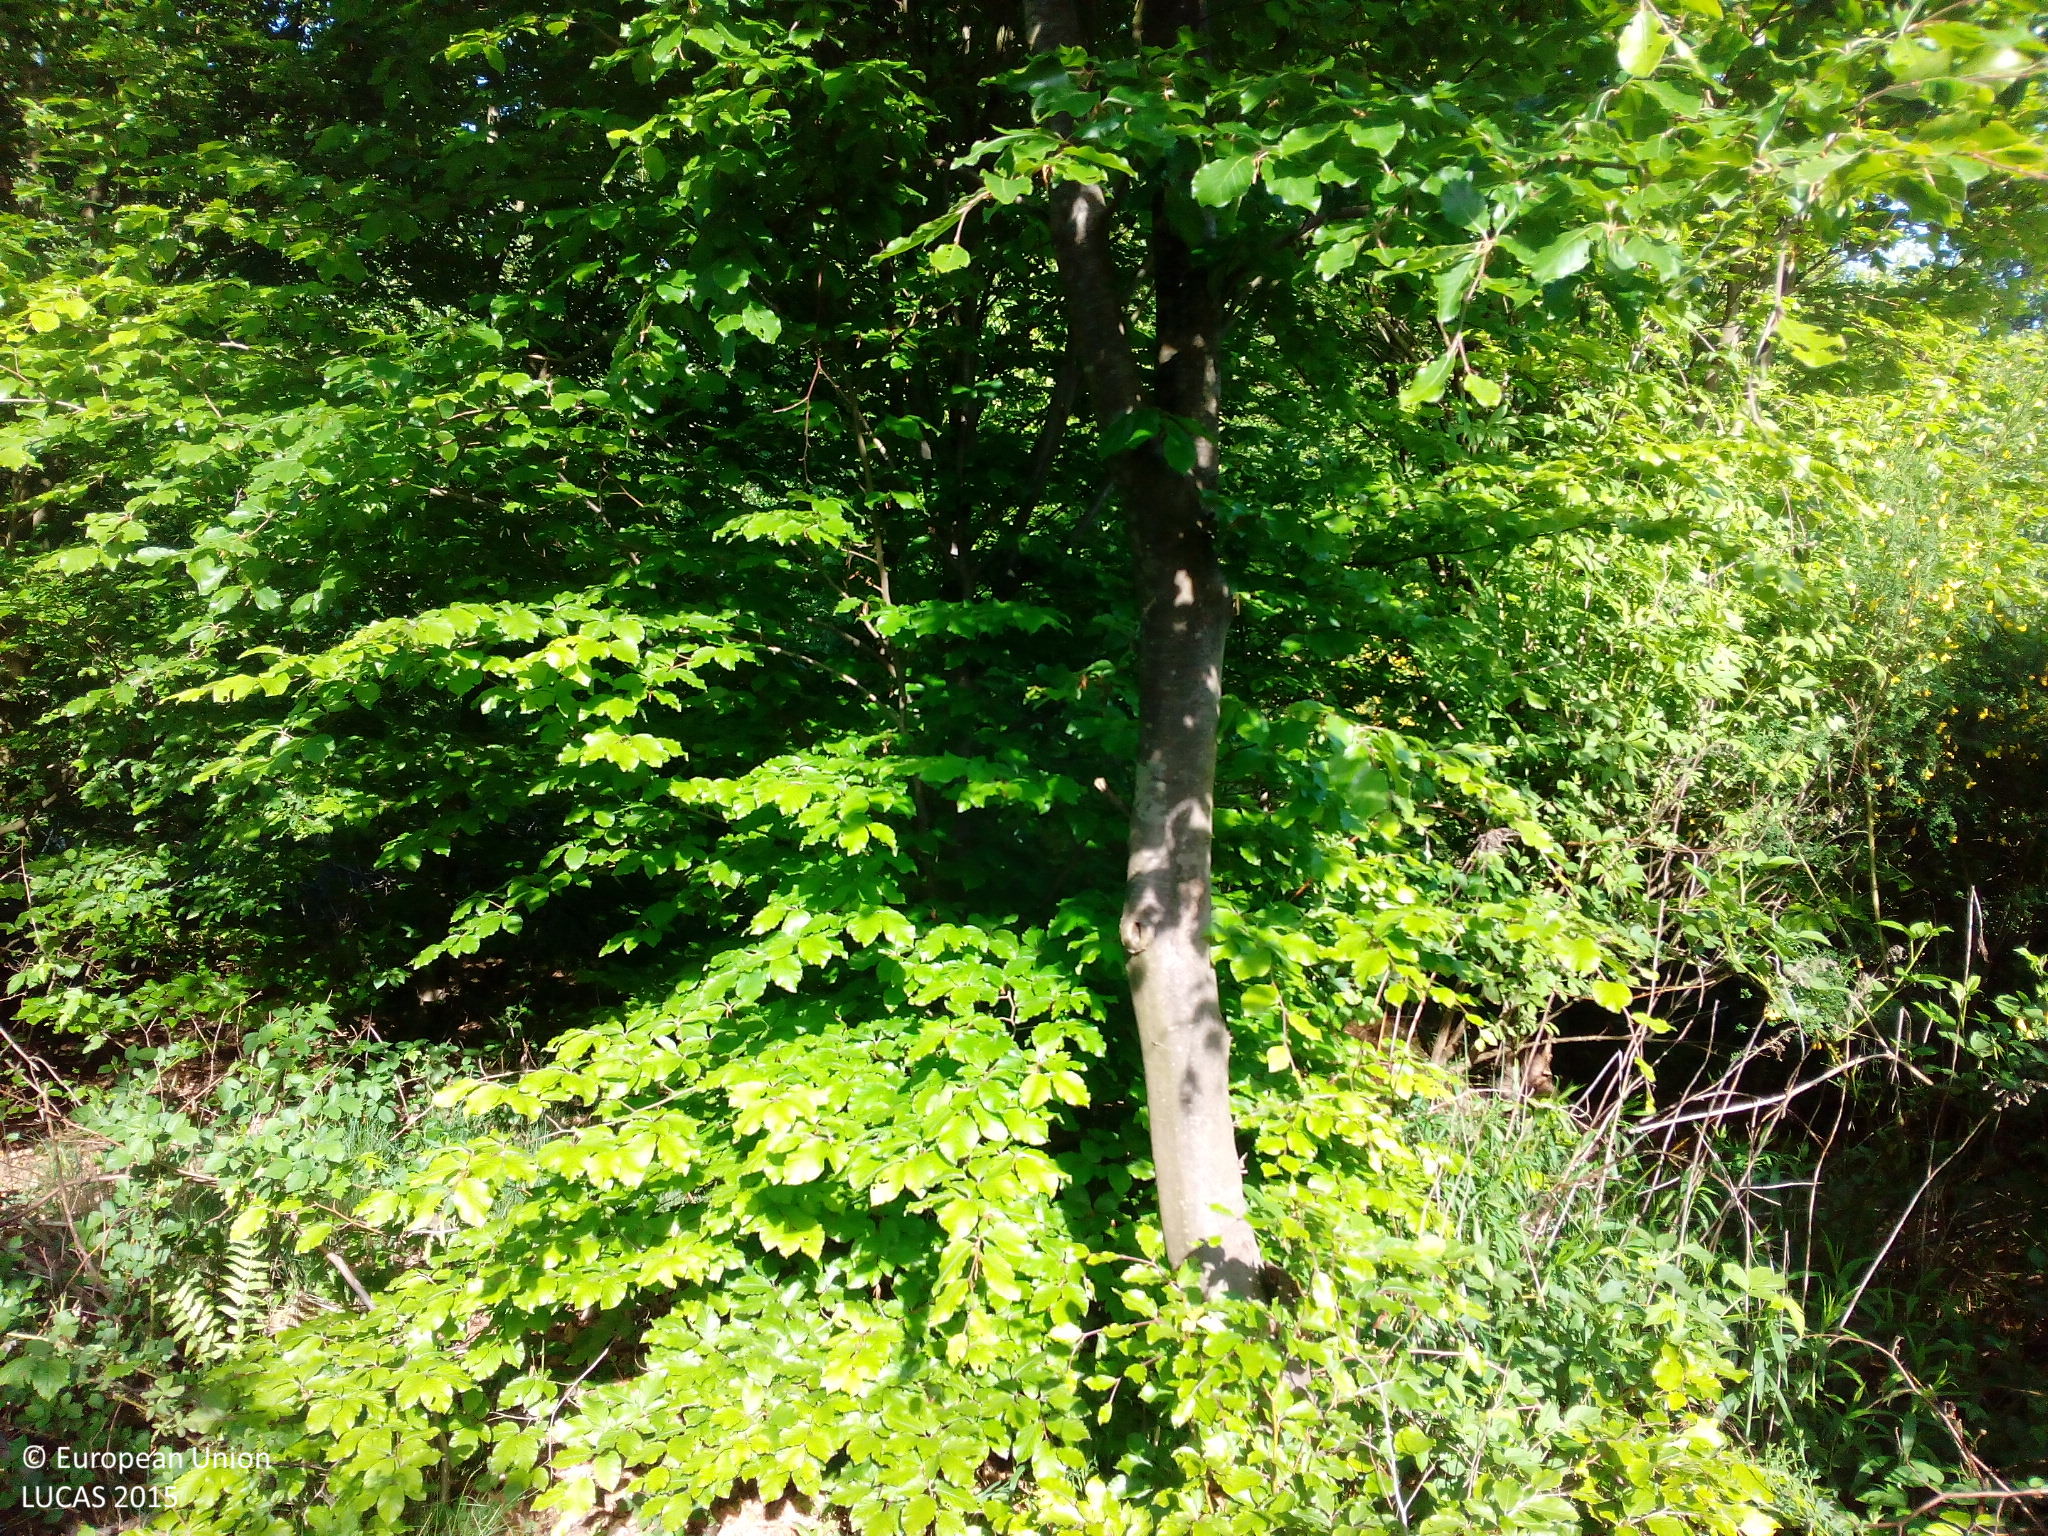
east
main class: Woodland
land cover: Broadleaved woodland
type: beech forest
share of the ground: 50 - 75 %
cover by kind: broadleaved forest trees 60 %, herbaceous plants 30 %, shrubs 5 %, unconsolidated bare surface 5 %
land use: Forestry
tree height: > 5 m
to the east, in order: Broadleaved woodland; Grassland without tree/shrub cover; Broadleaved woodland; Tracks; Broadleaved woodland
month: May
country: DE
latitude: 48.9820
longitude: 8.1560
